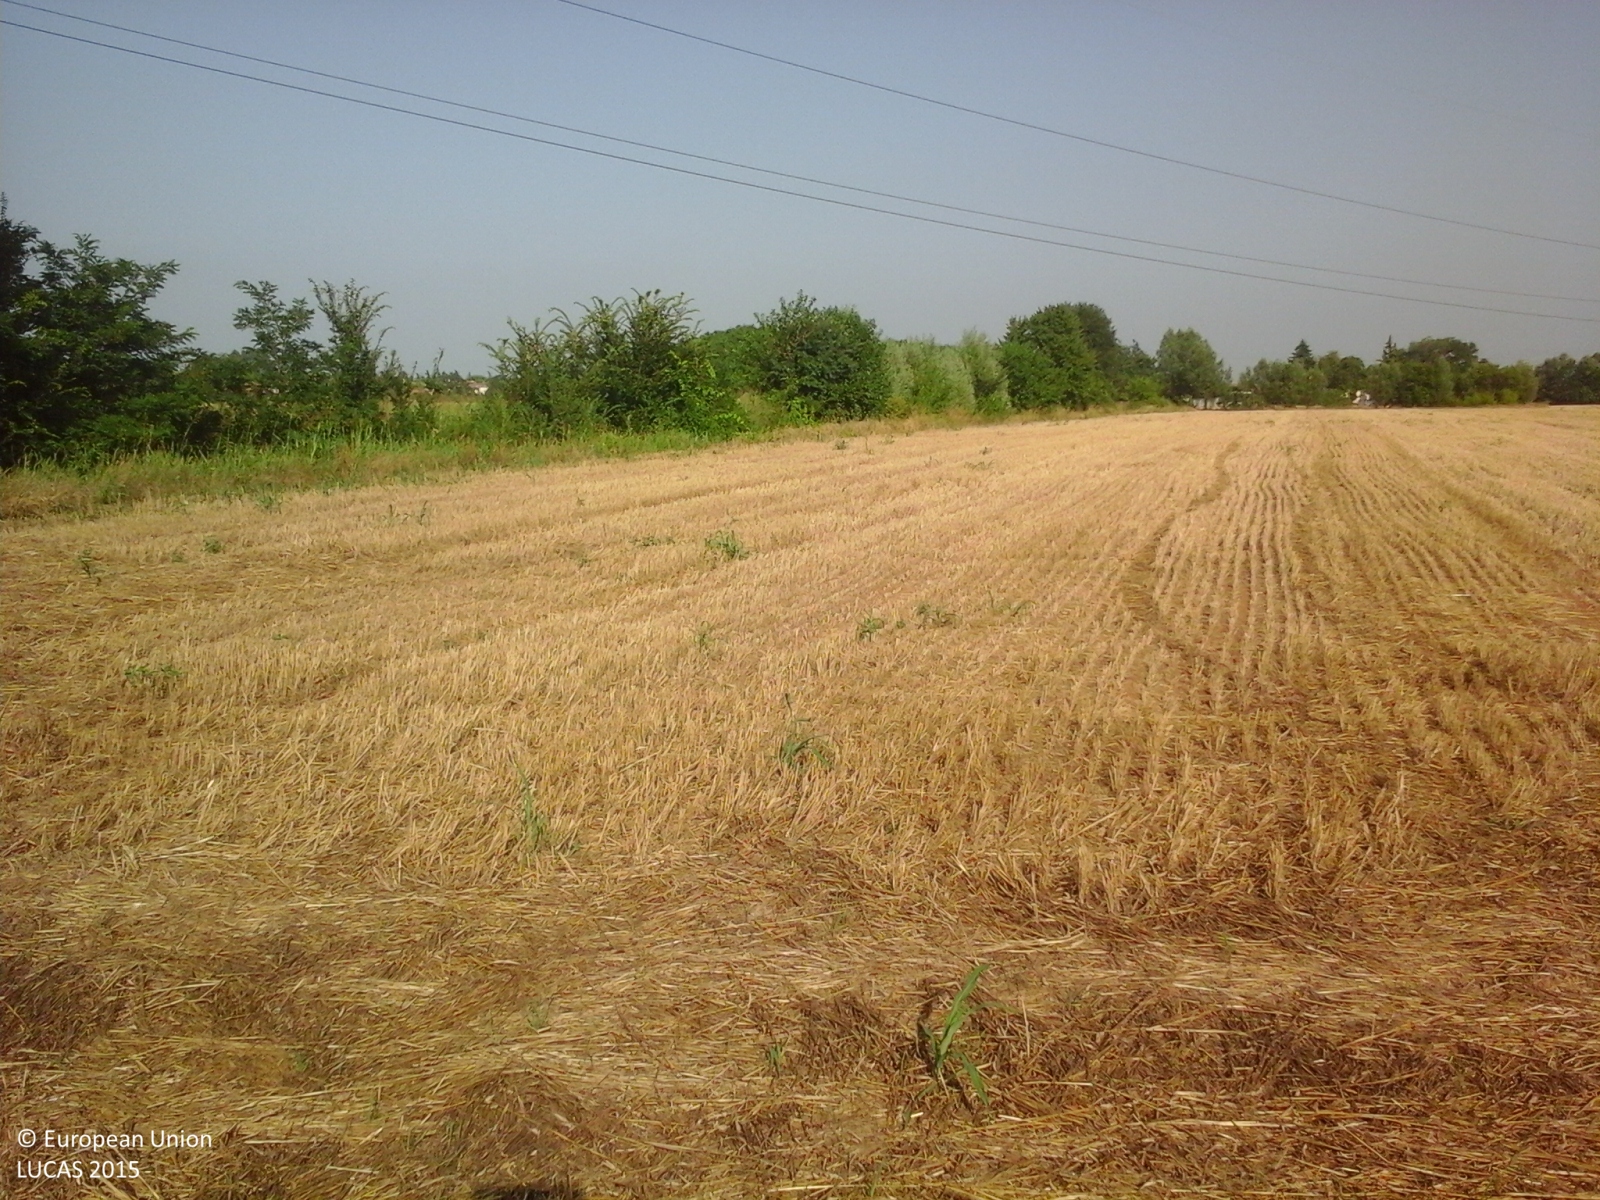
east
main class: Cropland
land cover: Common wheat
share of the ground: > 75 %
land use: Agriculture (excluding fallow land and kitchen gardens)
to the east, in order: Common wheat; Ditches and canals; Abandoned hedges; Temporary grasslands; Electric lines; Temporary grasslands; Common wheat; Ditches and canals; Common wheat
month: July
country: IT
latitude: 45.1767
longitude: 10.8256
